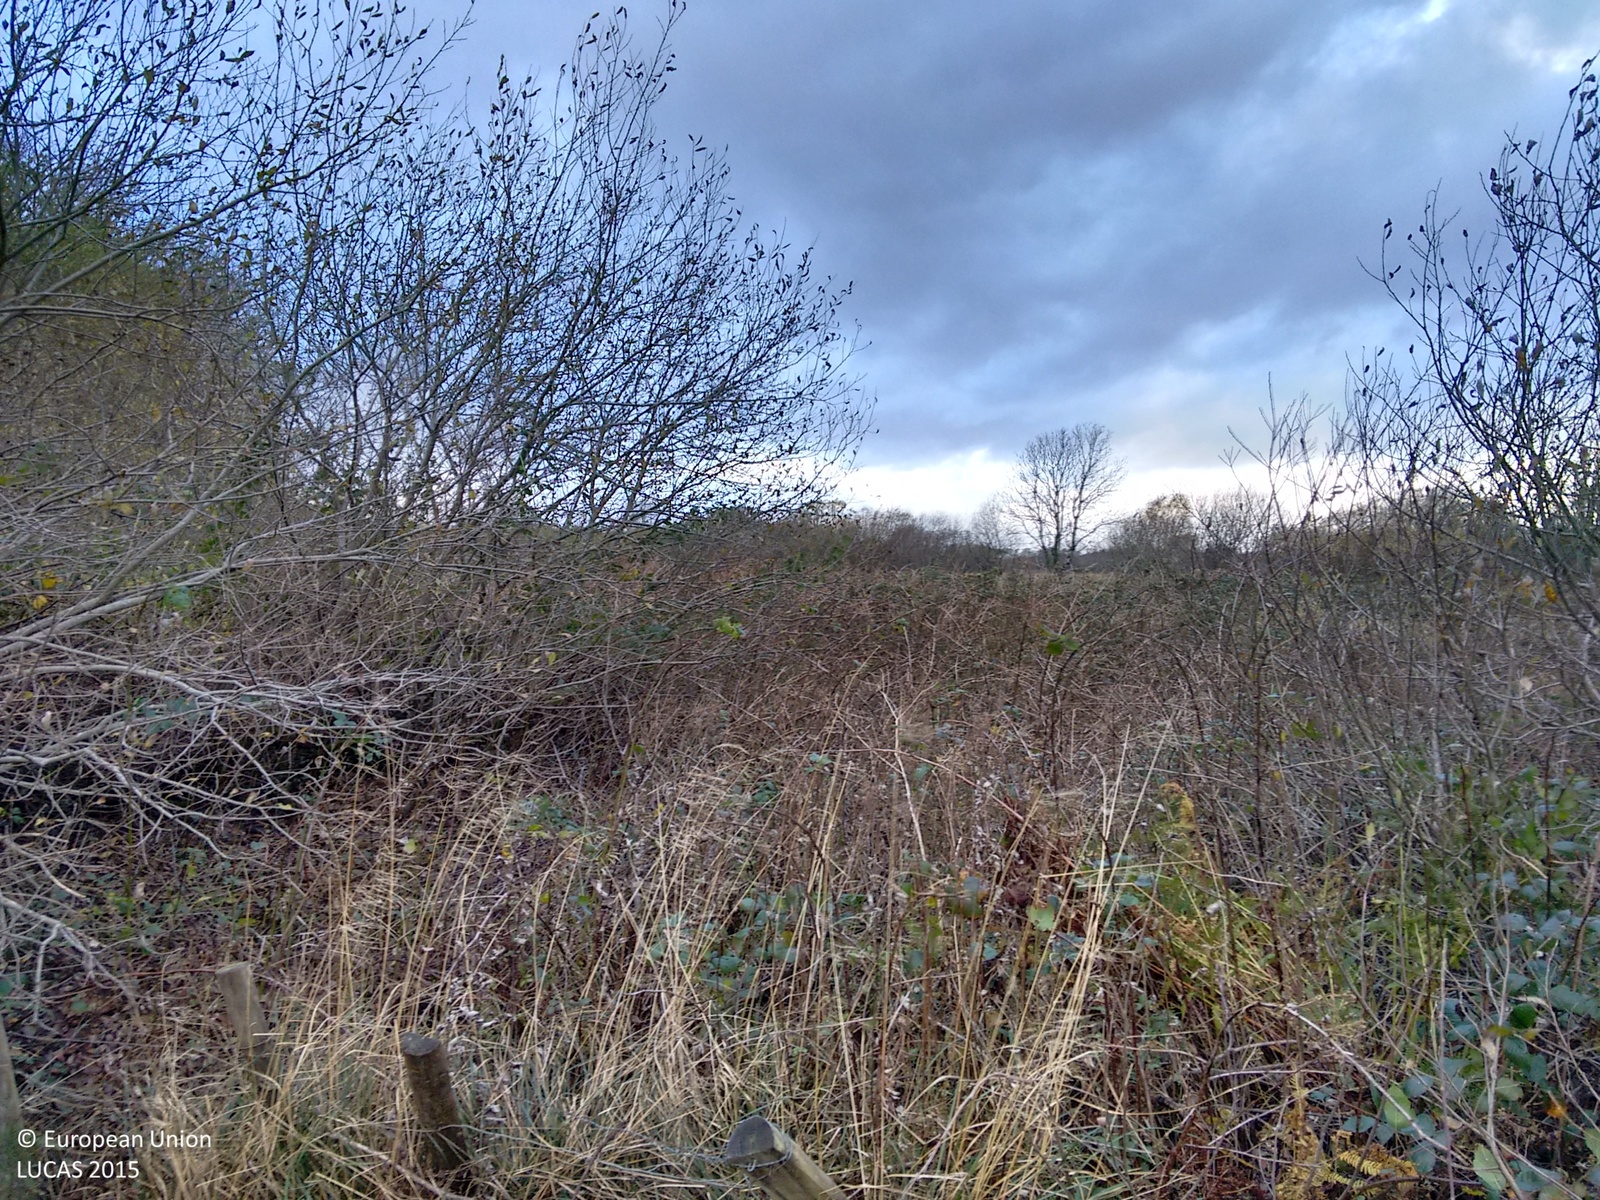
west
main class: Shrubland
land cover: Shrubland without tree cover
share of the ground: > 75 %
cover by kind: shrubs 70 %, herbaceous plants 30 %
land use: Agriculture (excluding fallow land and kitchen gardens)
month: November
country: IE
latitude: 54.7848
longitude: -8.2660
